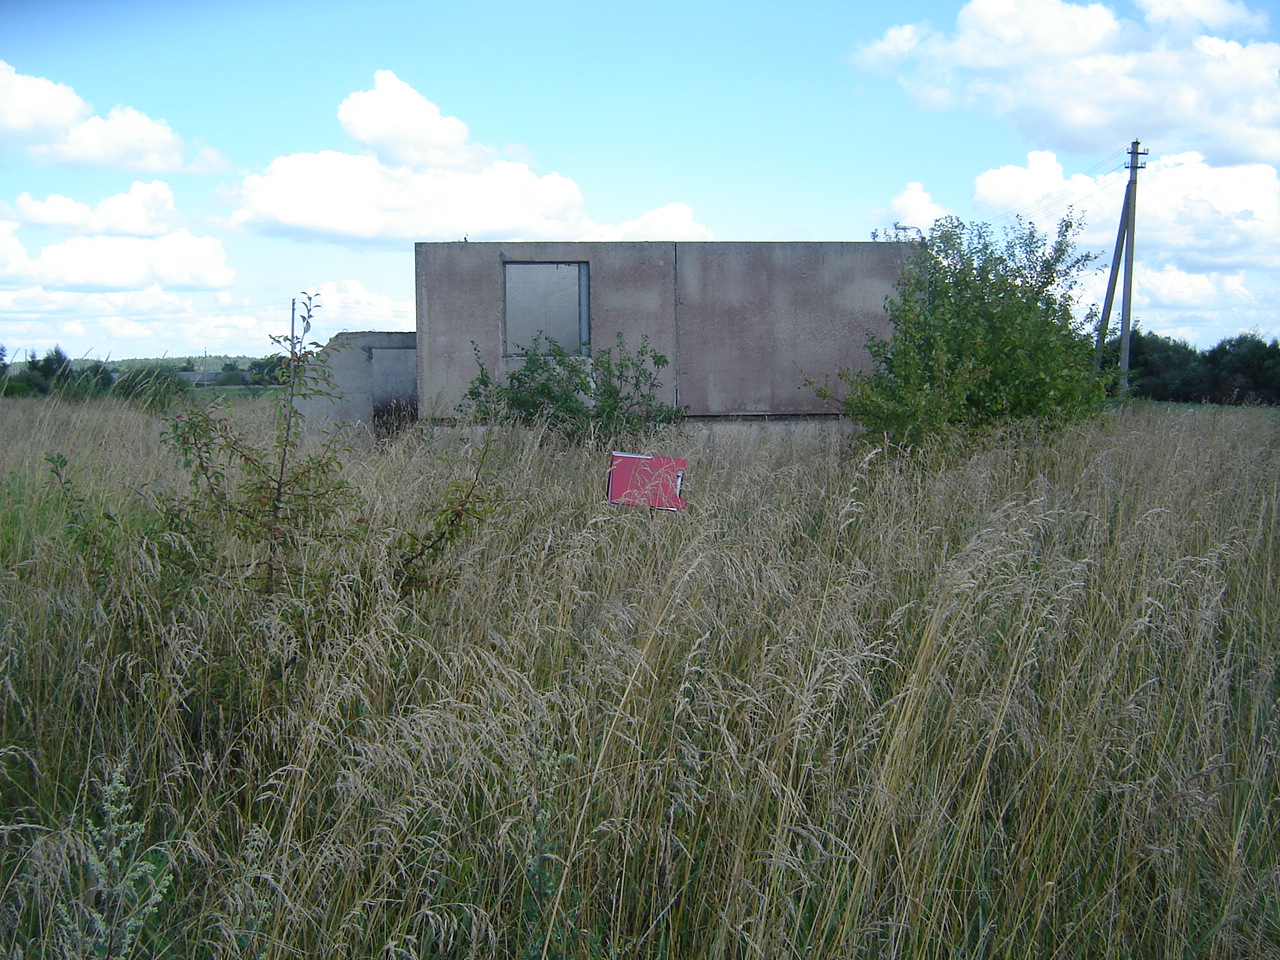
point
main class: Grassland
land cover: Spontaneously vegetated surfaces
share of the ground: > 75 %
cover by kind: herbaceous plants 95 %, shrubs 5 %
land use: Abandoned areas
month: August
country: LT
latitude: 55.0187
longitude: 24.8909
